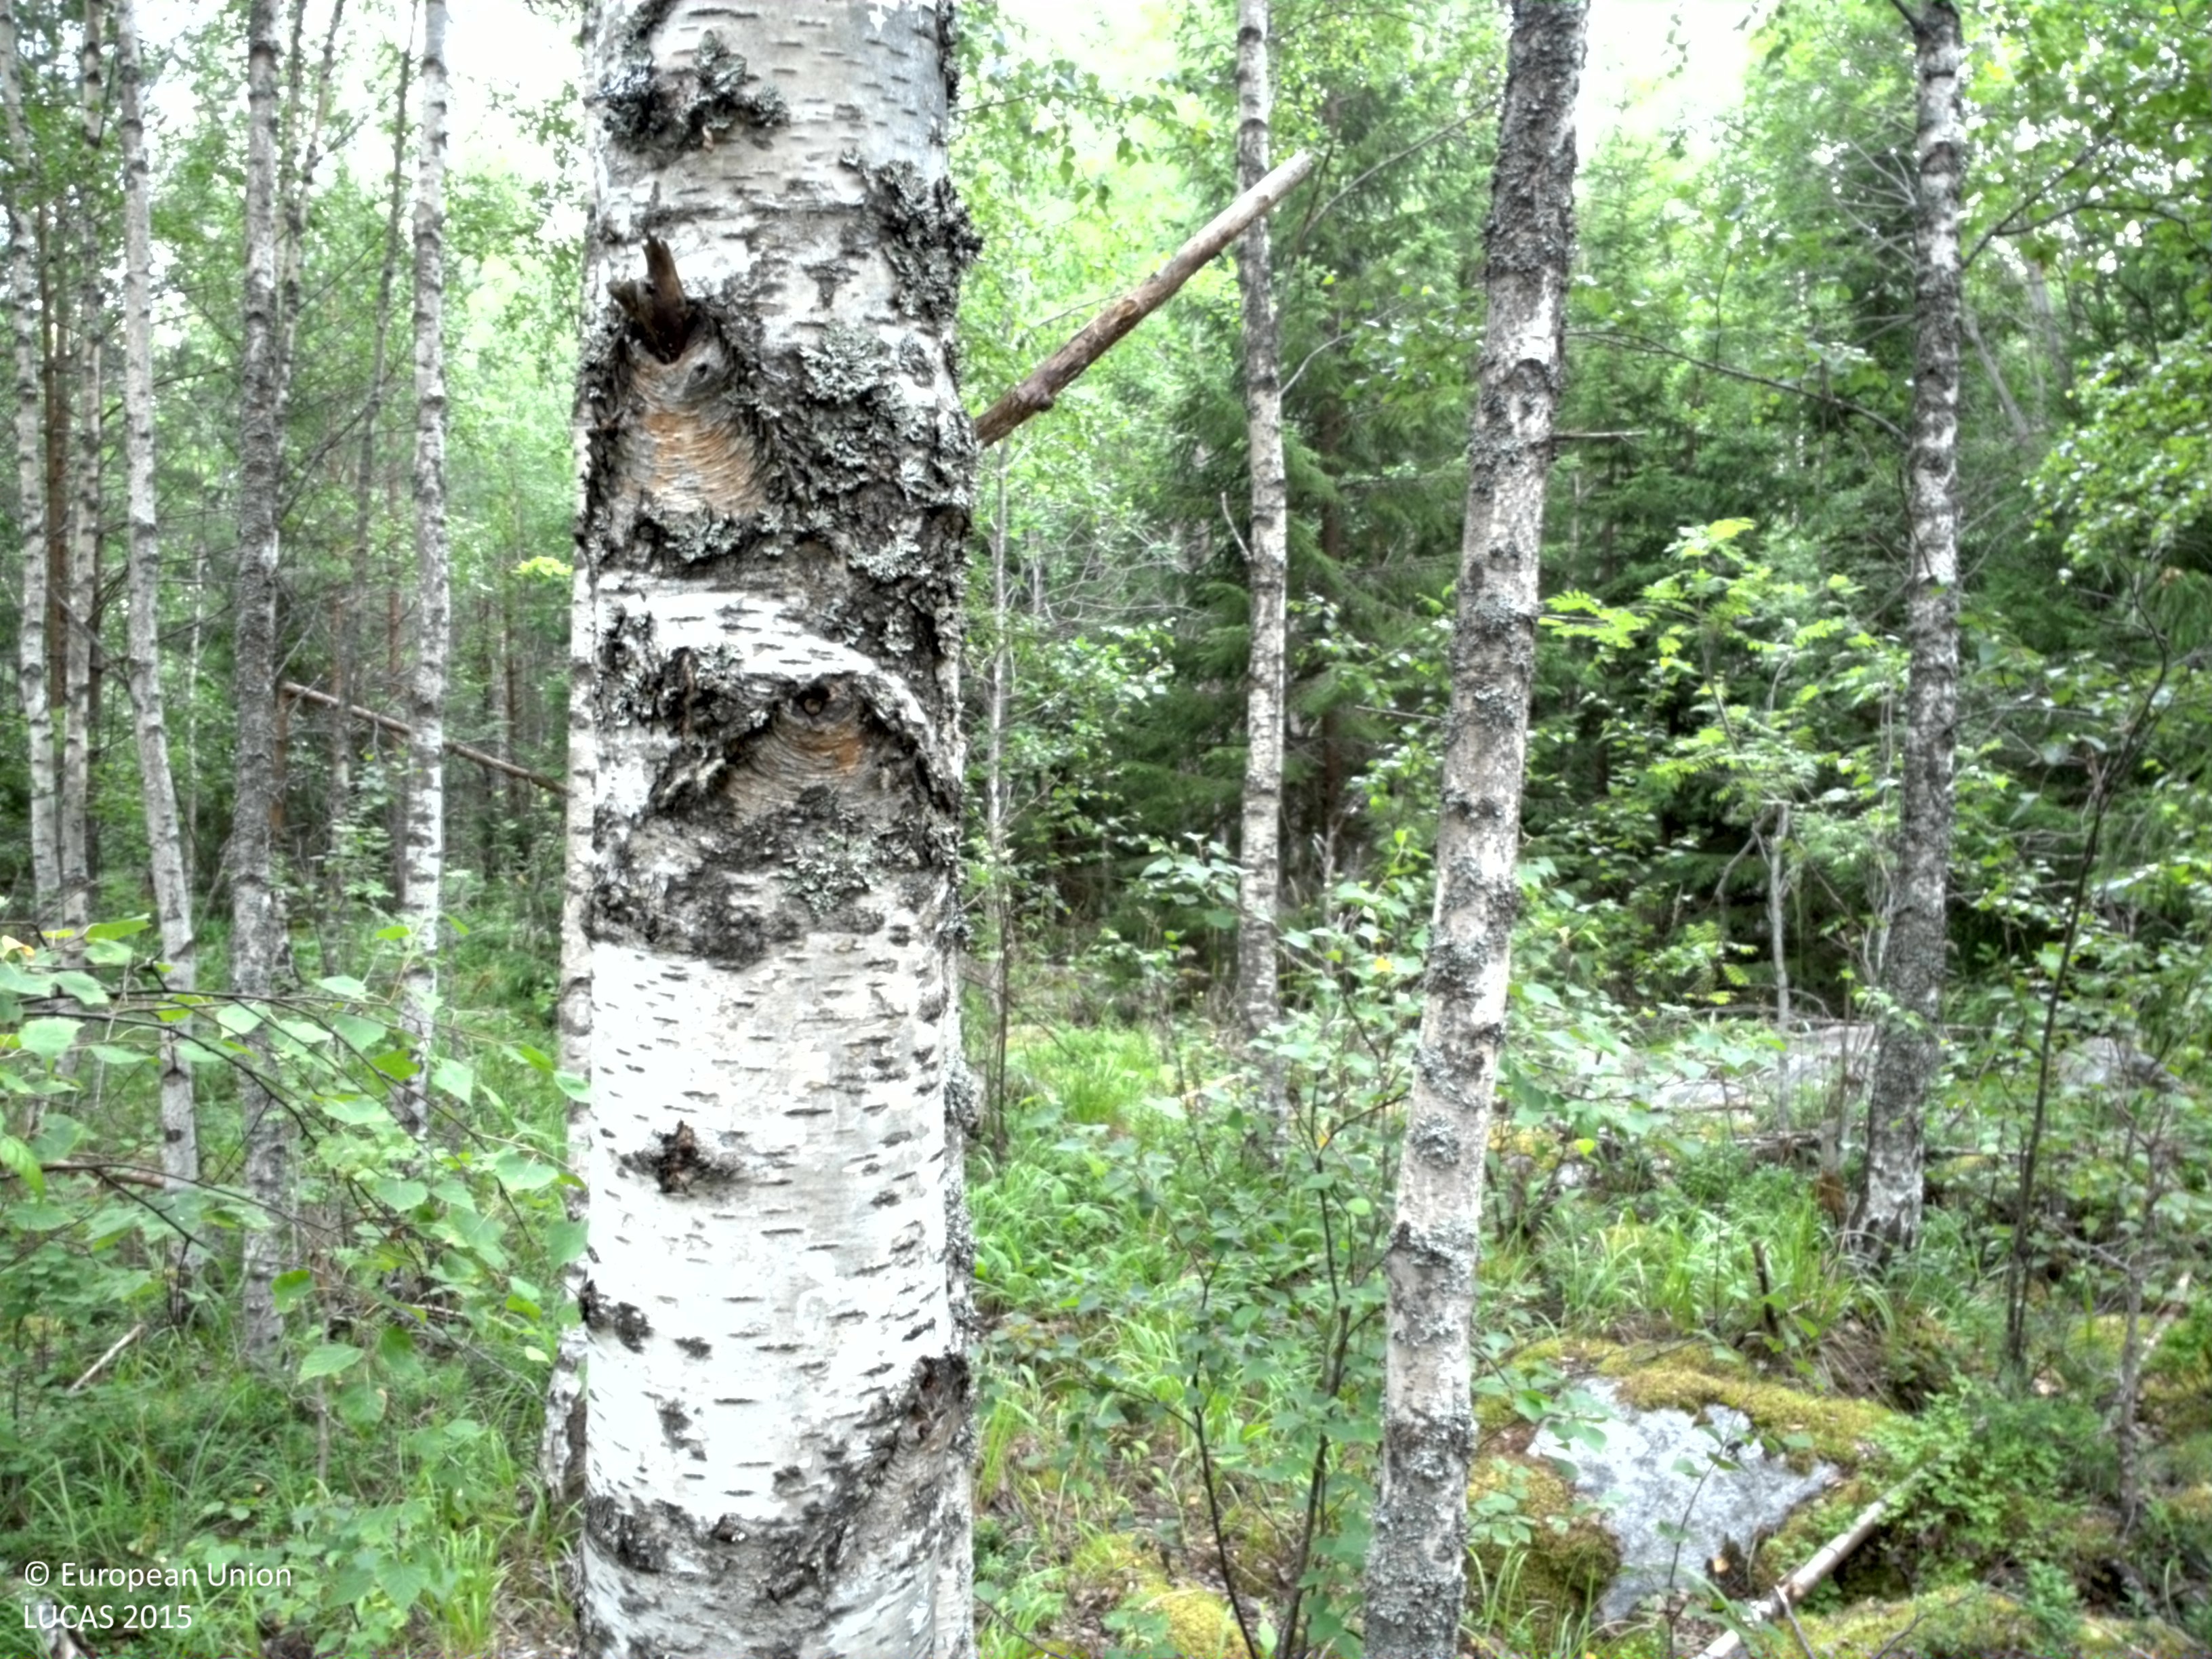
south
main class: Woodland
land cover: Spruce dominated mixed woodland
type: boreal forest
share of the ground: 50 - 75 %
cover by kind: coniferous forest trees 45 %, lichens and mosses 20 %, broadleaved forest trees 15 %, herbaceous plants 10 %, consolidated bare surface 10 %
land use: Forestry
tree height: > 5 m
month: July
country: SE
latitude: 59.7971
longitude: 18.4993
